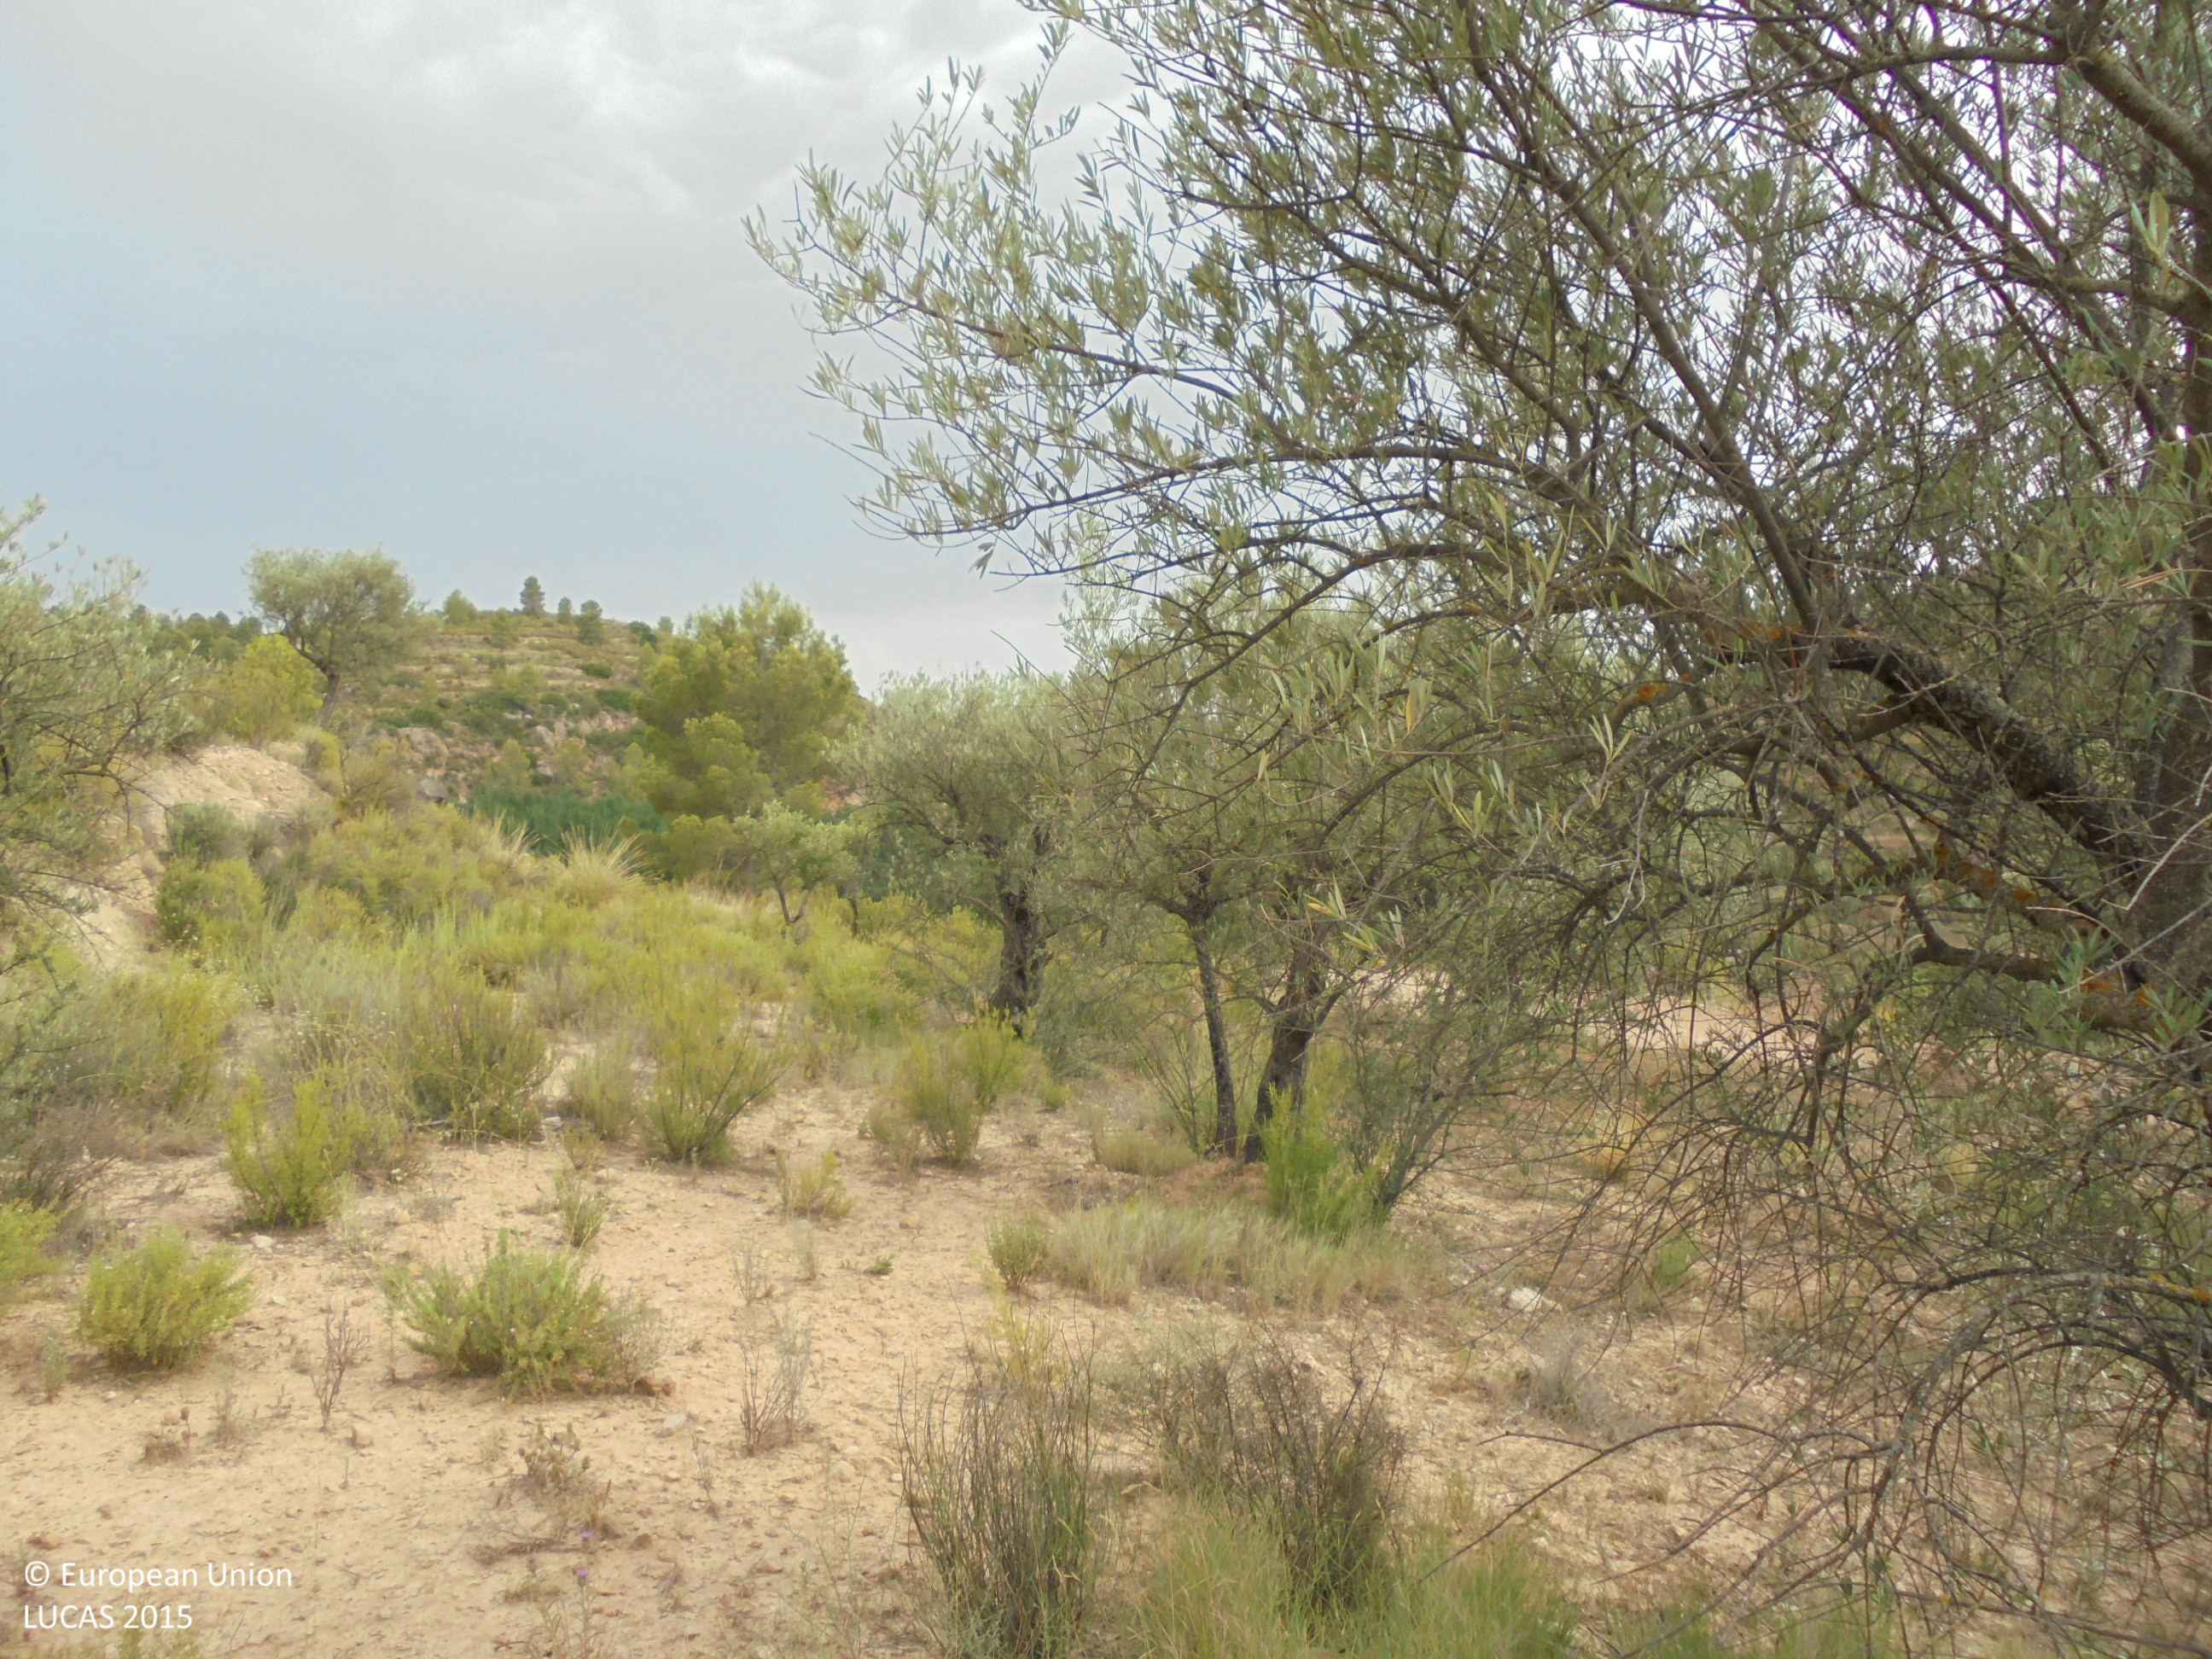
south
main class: Cropland
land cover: Olive groves
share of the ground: 25 - 50 %
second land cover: Shrubland without tree cover
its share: 25 - 50 %
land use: Abandoned areas
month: August
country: ES
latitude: 39.1486
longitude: -1.0474
